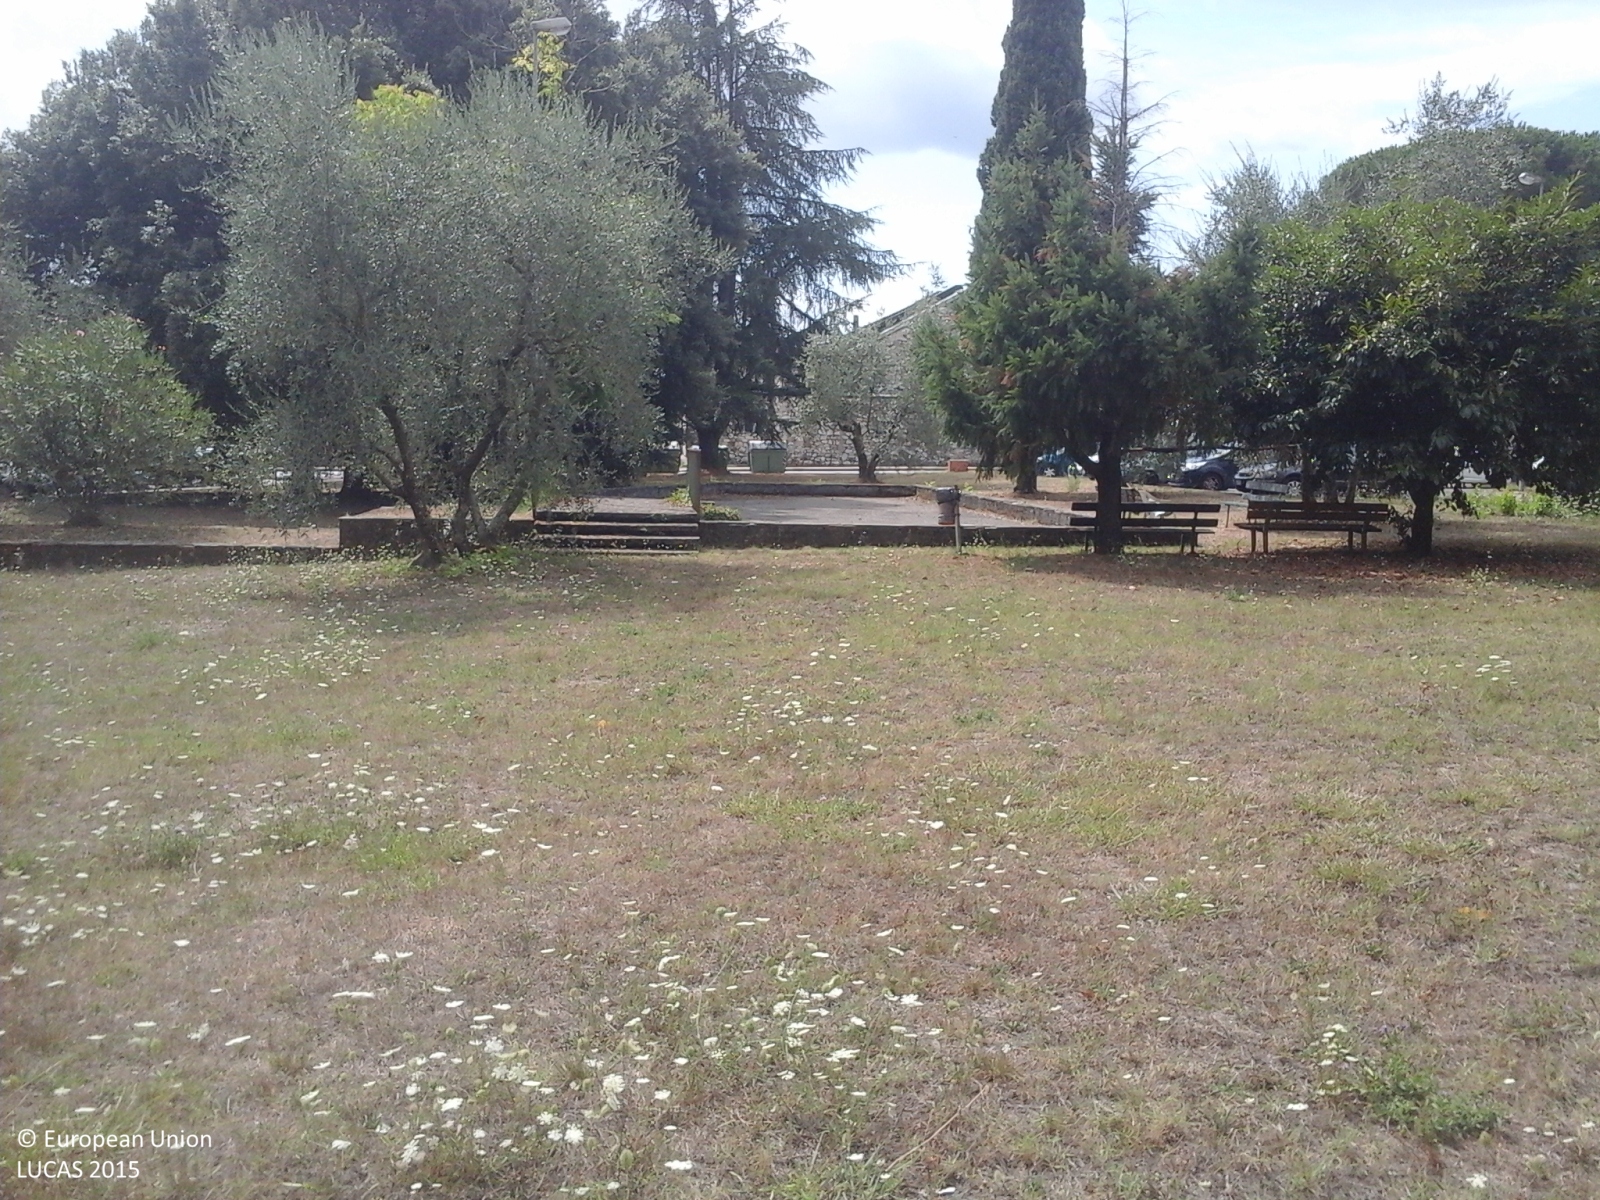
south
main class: Cropland
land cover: Olive groves
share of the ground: > 75 %
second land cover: Grassland without tree/shrub cover
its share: > 75 %
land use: Community services
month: August
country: IT
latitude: 43.9497
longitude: 10.9073
